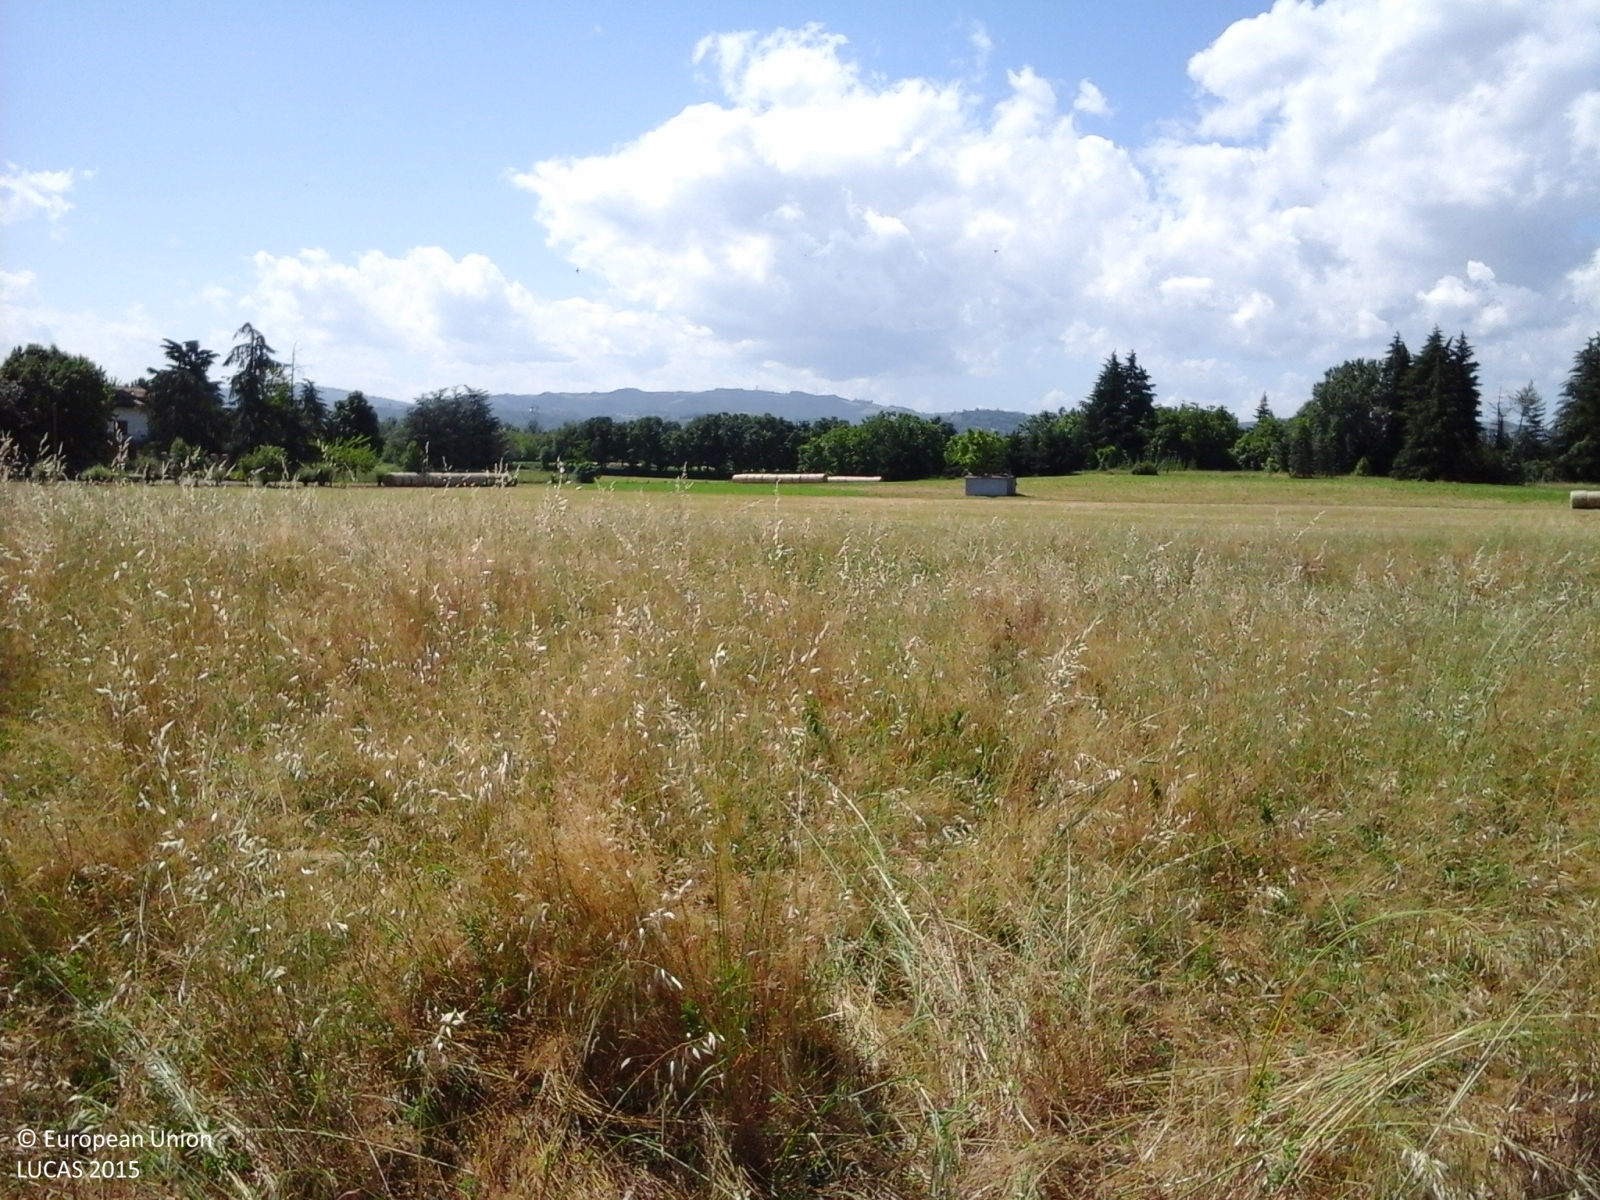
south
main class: Grassland
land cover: Spontaneously vegetated surfaces
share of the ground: > 75 %
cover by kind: herbaceous plants 100 %
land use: Agriculture (excluding fallow land and kitchen gardens)
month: May
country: IT
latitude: 44.6555
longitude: 10.5914
